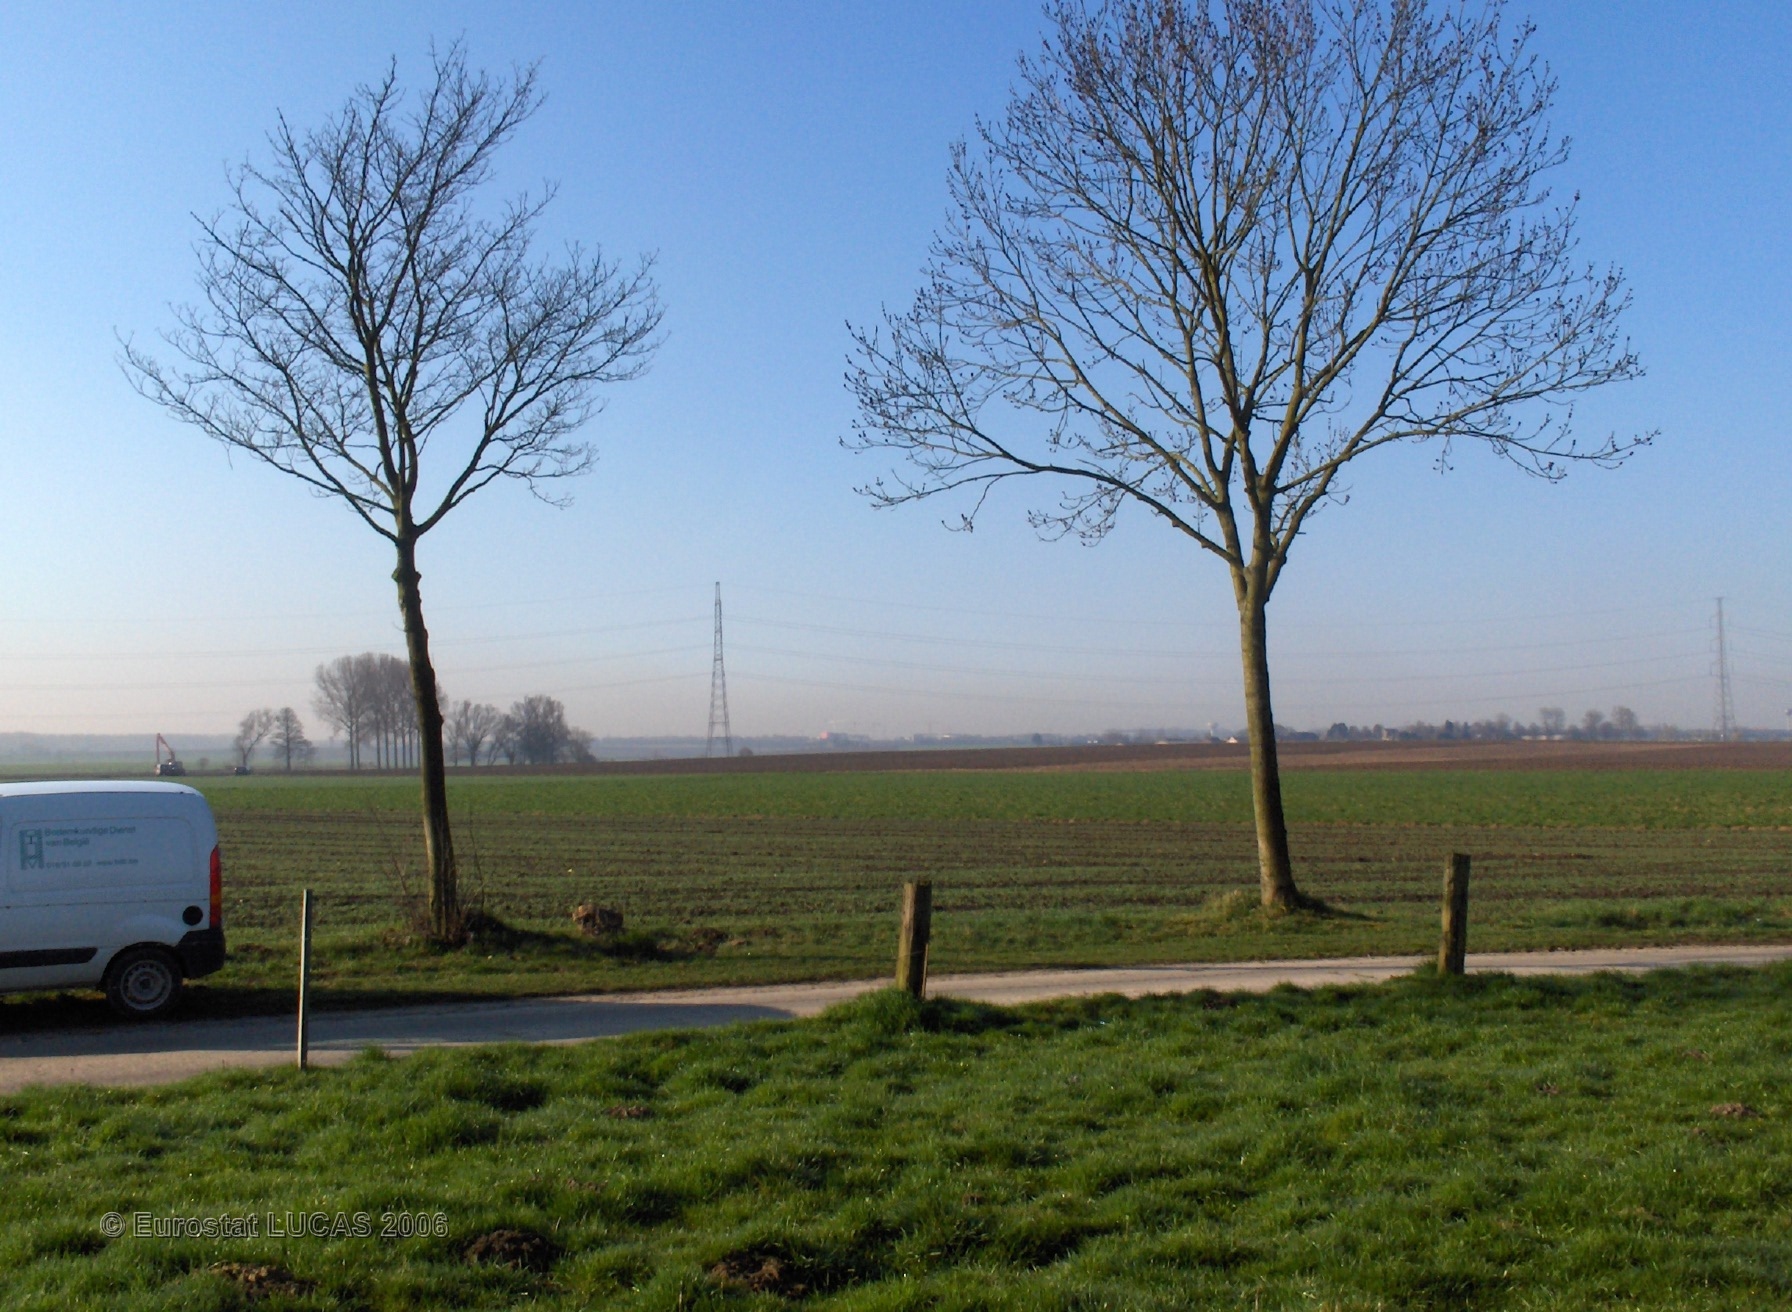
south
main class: Grassland
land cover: Grassland without tree/shrub cover
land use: Agriculture (excluding fallow land and kitchen gardens)
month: April
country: BE
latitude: 50.5013
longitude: 4.4832
